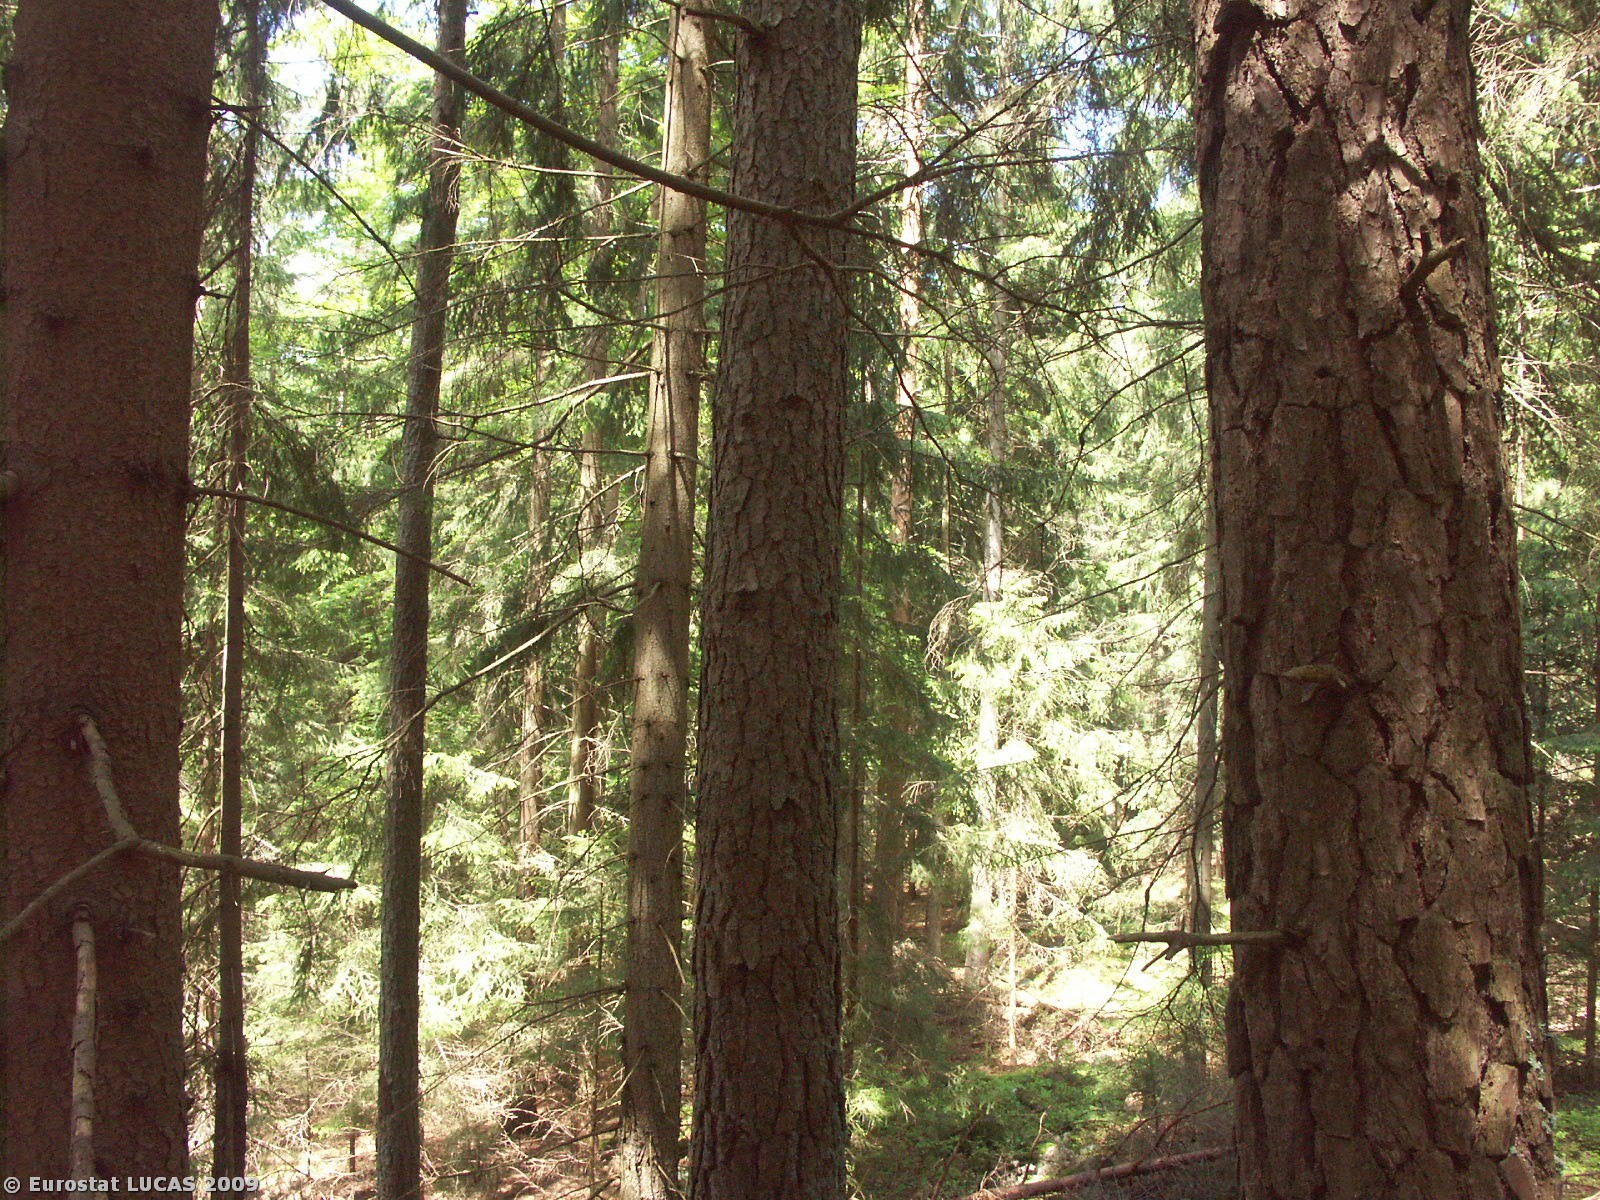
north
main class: Woodland
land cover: Coniferous woodland
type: hemiboreal forest and nemoral coniferous forest and mixed broadleaved-coniferous forest
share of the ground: > 75 %
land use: Forestry
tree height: > 5 m
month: May
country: CZ
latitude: 48.7028
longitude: 14.6346
